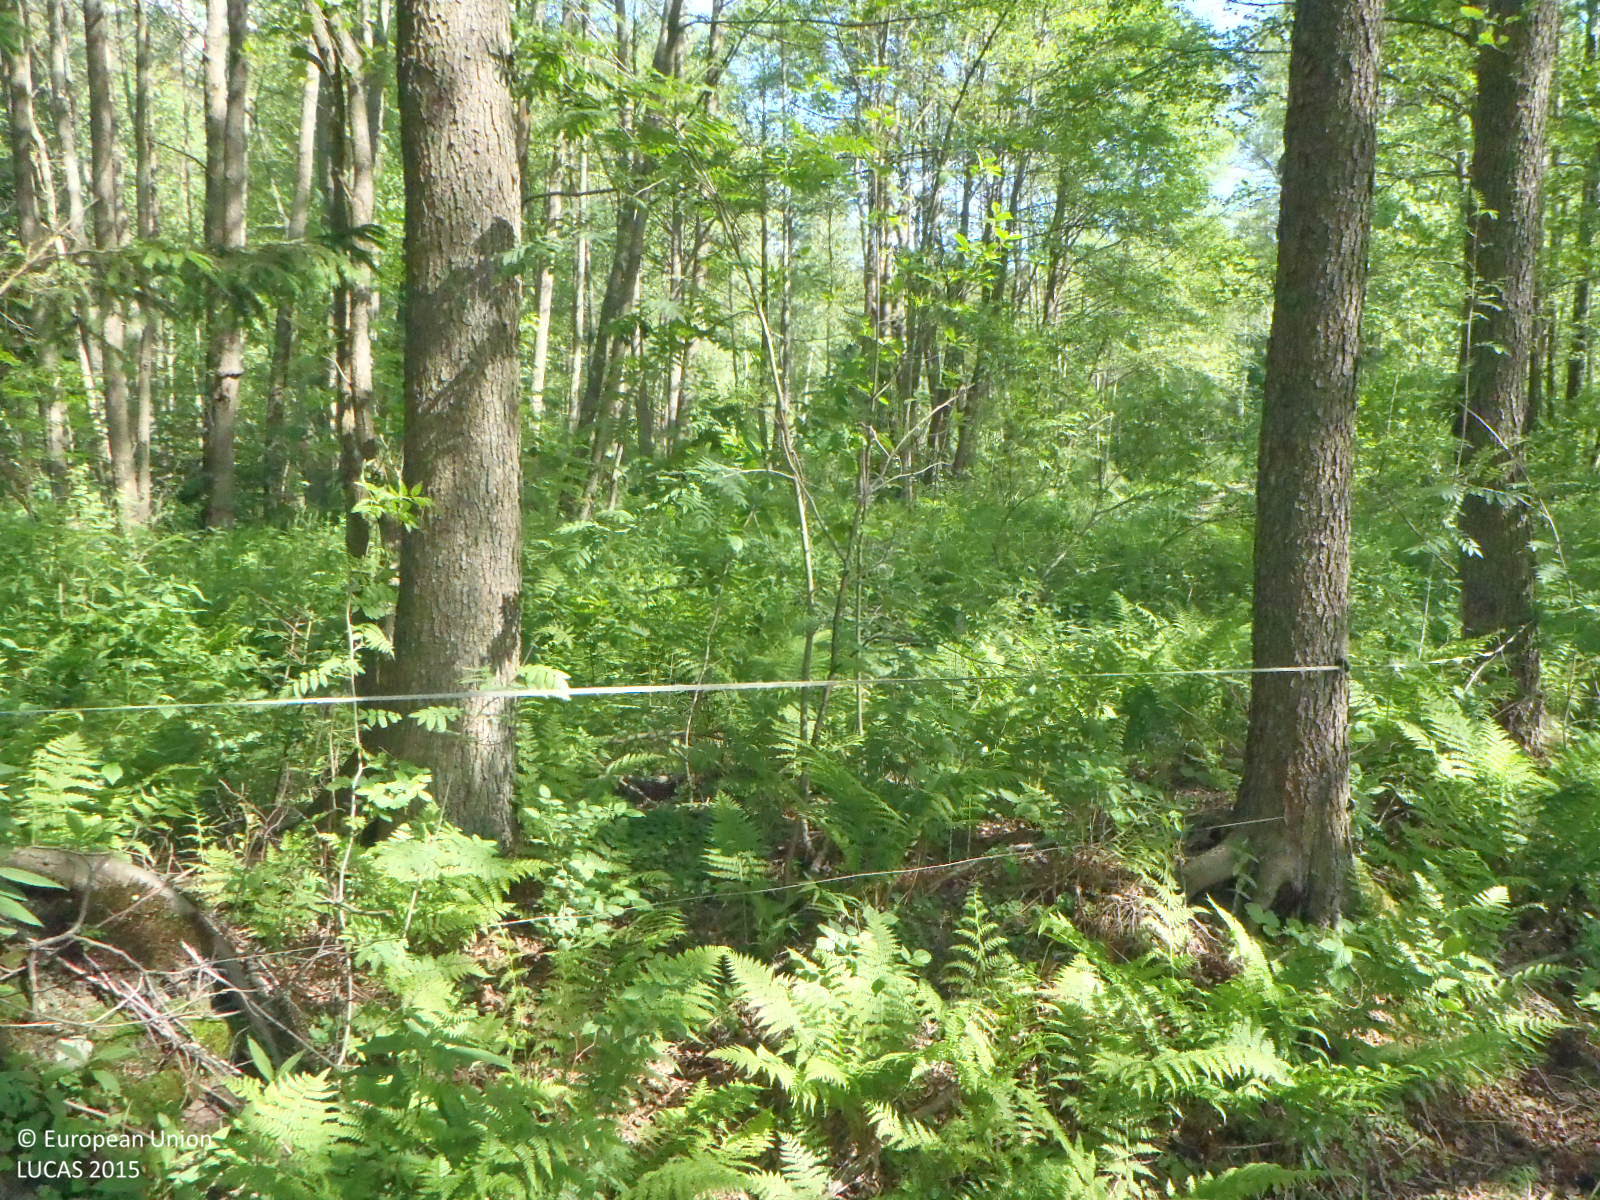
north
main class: Woodland
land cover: Broadleaved woodland
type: mire and swamp forests
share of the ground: > 75 %
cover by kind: broadleaved forest trees 80 %, herbaceous plants 10 %, coniferous forest trees 5 %
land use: Agriculture (excluding fallow land and kitchen gardens)
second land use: Forestry
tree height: > 5 m
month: June
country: CZ
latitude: 48.7589
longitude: 14.5854
